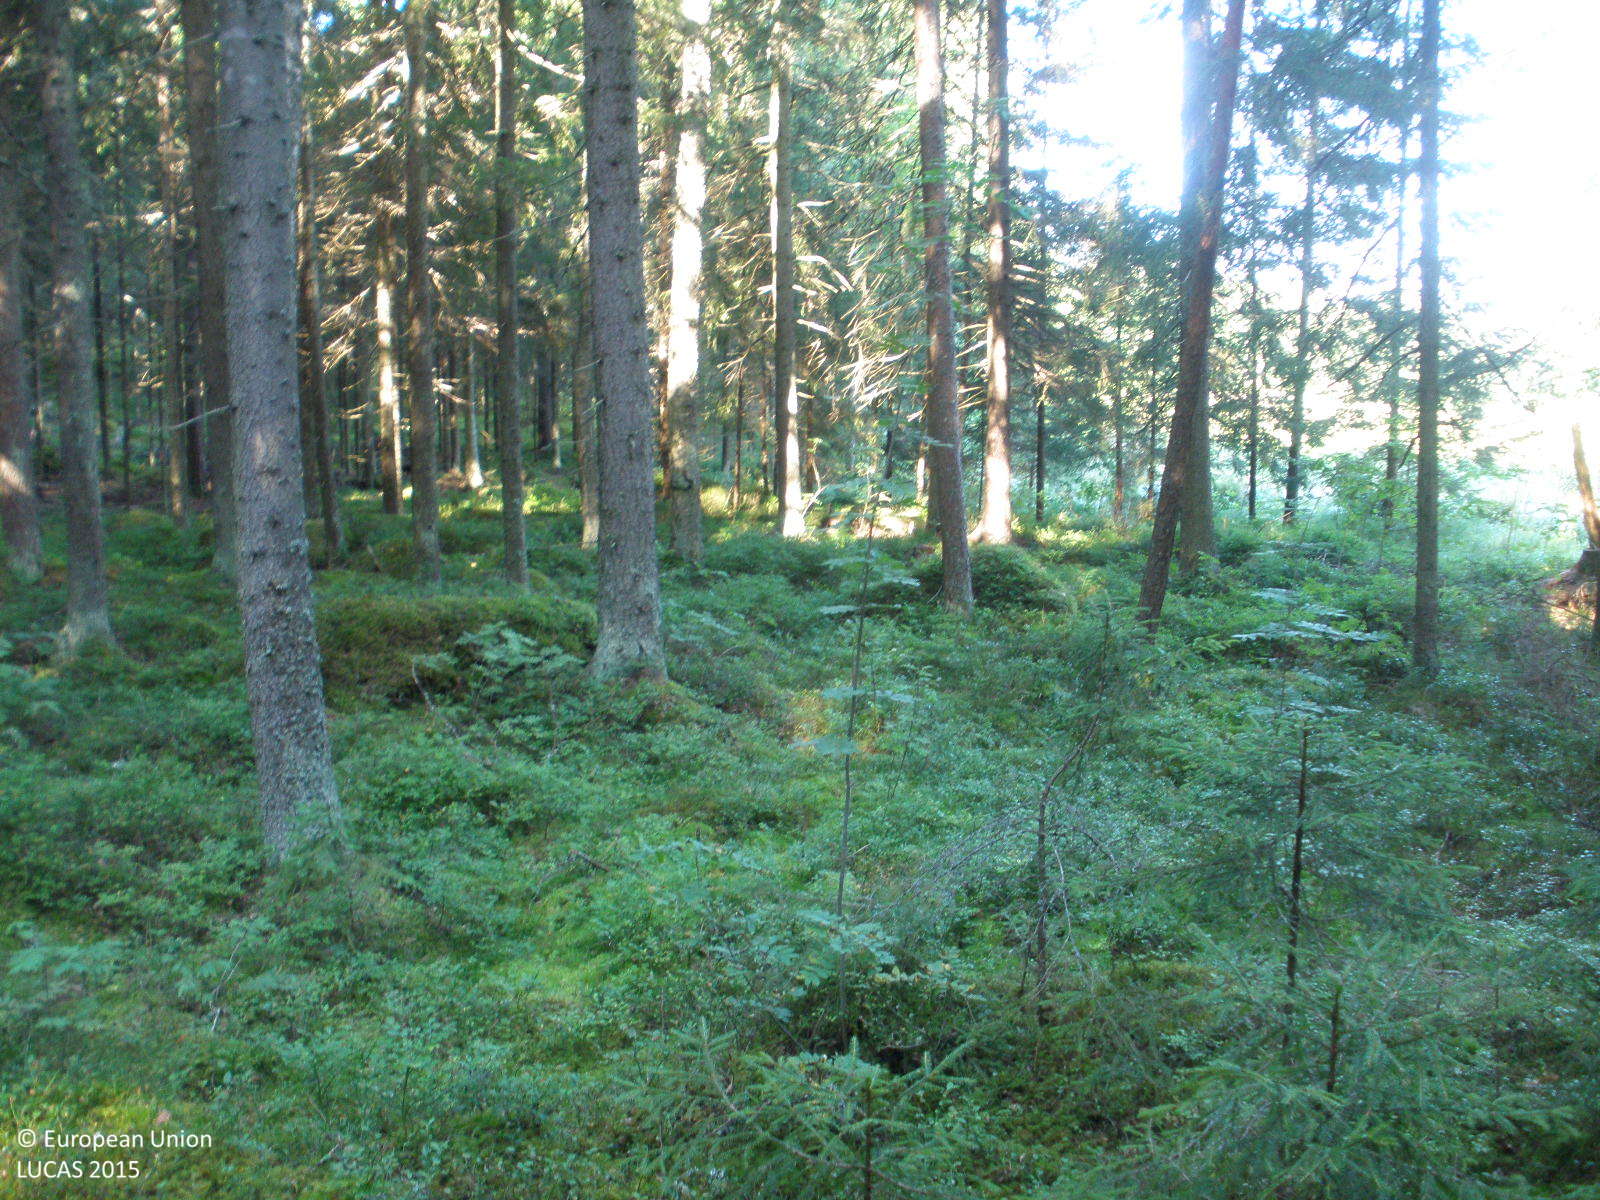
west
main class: Woodland
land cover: Spruce dominated coniferous woodland
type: boreal forest
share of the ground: > 75 %
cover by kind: coniferous forest trees 85 %, shrubs 5 %, herbaceous plants 5 %, lichens and mosses 5 %
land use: Forestry
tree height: > 5 m
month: August
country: FI
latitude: 60.9276
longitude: 24.8892
